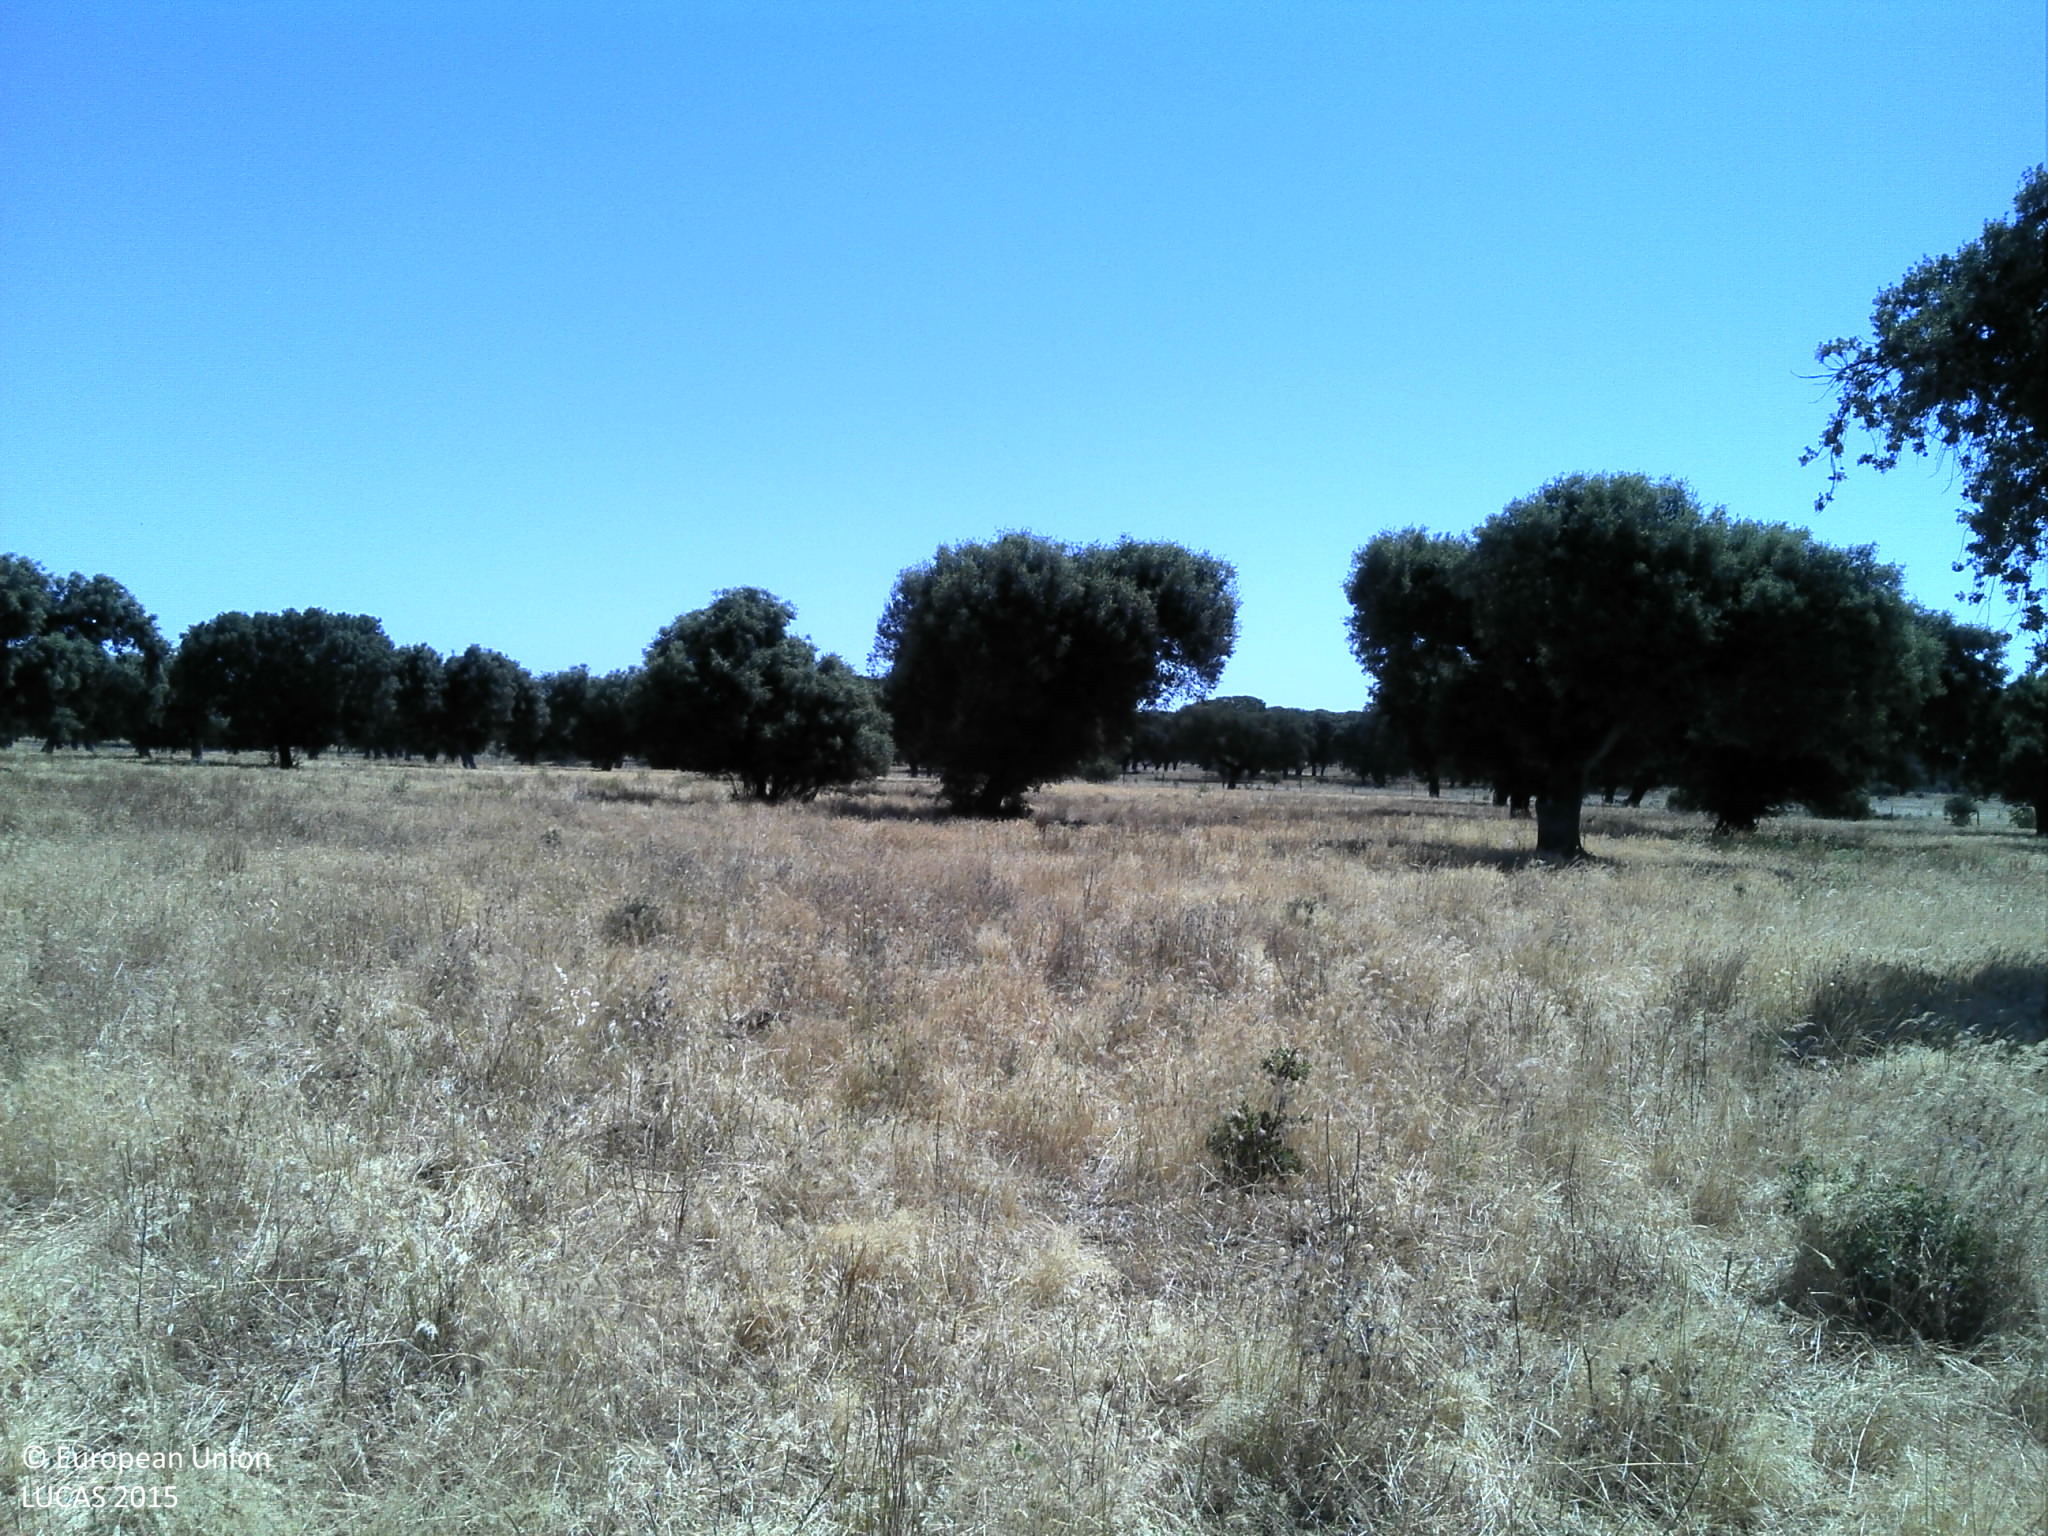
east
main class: Woodland
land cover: Broadleaved woodland
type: broadleaved evergreen forest
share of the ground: 10 - 25 %
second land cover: Grassland without tree/shrub cover
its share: 50 - 75 %
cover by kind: herbaceous plants 70 %, unconsolidated bare surface 20 %, broadleaved forest trees 10 %
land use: Forestry
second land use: Agriculture (excluding fallow land and kitchen gardens)
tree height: > 5 m
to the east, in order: Broadleaved woodland; Grassland without tree/shrub cover; Broadleaved woodland; Grassland without tree/shrub cover; Fences; Other bare soil; Tracks; Broadleaved woodland; Grassland without tree/shrub cover
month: May
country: PT
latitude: 39.0077
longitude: -7.6285
